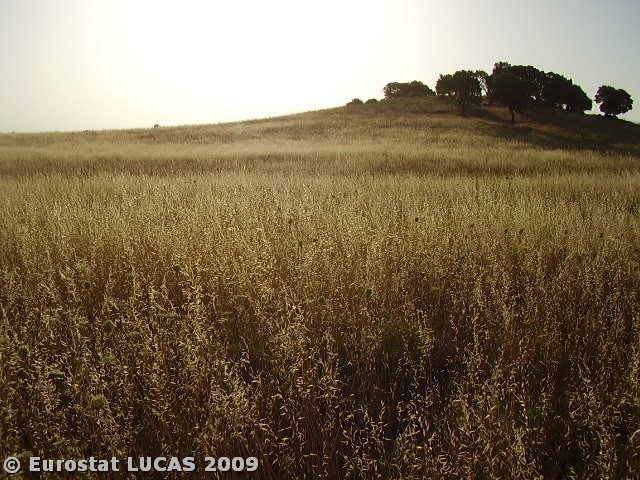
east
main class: Grassland
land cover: Spontaneously vegetated surfaces
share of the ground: > 75 %
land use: Fallow land
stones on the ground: 25 - 50 %
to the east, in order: Spontaneously vegetated surfaces; Broadleaved woodland; Rock outcrops; Broadleaved woodland; Spontaneously vegetated surfaces
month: June
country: PT
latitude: 38.6508
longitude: -7.9557
